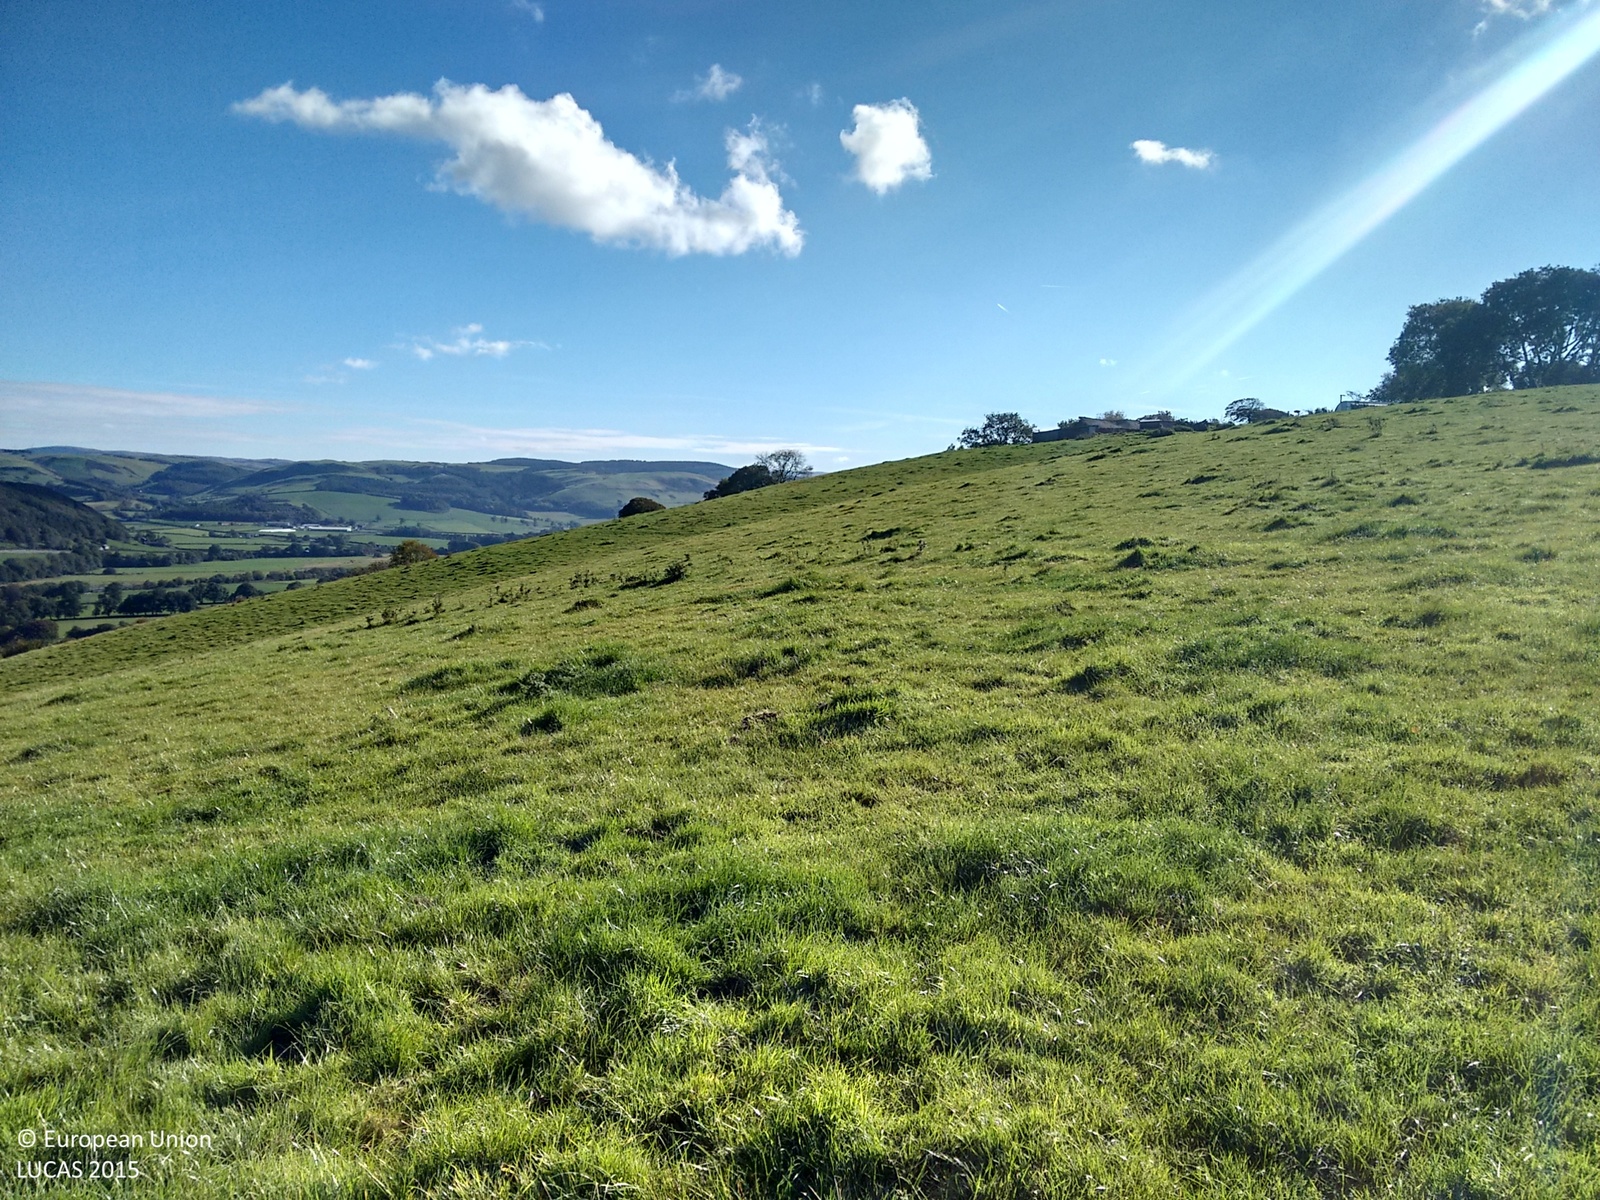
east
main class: Grassland
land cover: Grassland without tree/shrub cover
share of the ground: > 75 %
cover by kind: herbaceous plants 100 %
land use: Agriculture (excluding fallow land and kitchen gardens)
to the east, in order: Grassland without tree/shrub cover
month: October
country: GB
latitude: 52.3462
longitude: -3.9960
